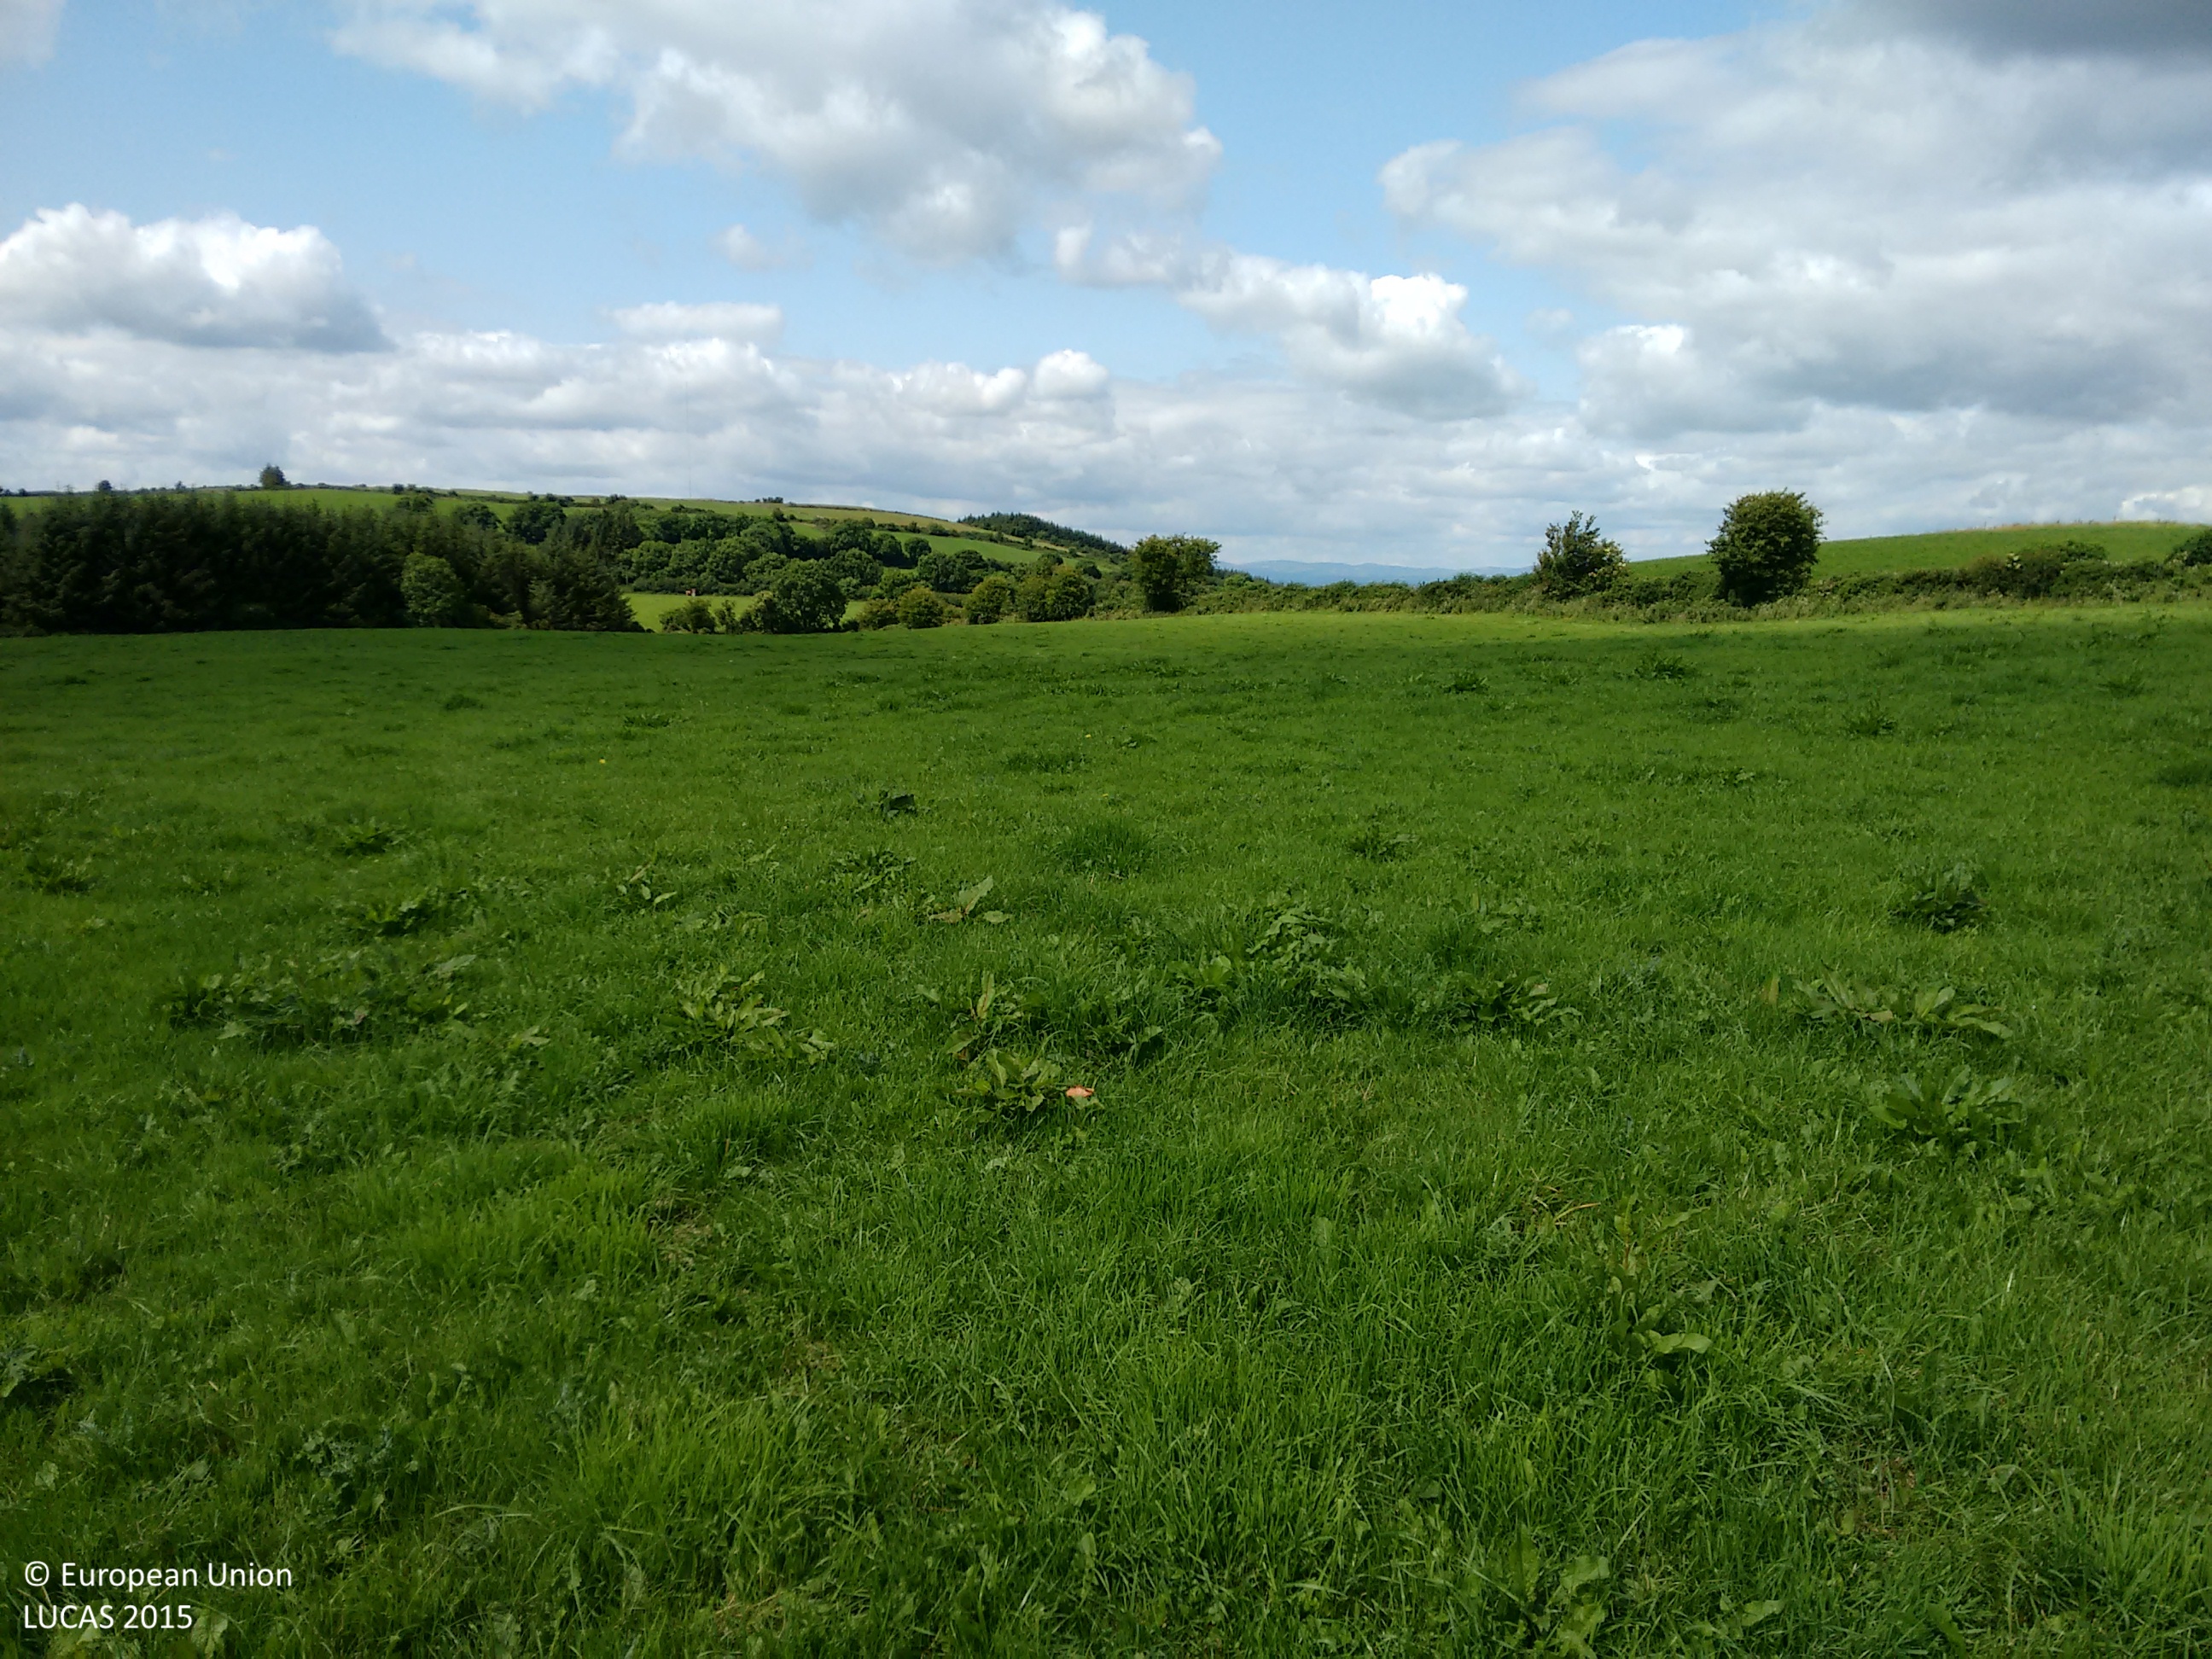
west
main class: Grassland
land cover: Grassland without tree/shrub cover
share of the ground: > 75 %
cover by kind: herbaceous plants 100 %
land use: Agriculture (excluding fallow land and kitchen gardens)
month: July
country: IE
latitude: 52.6346
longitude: -7.5826
